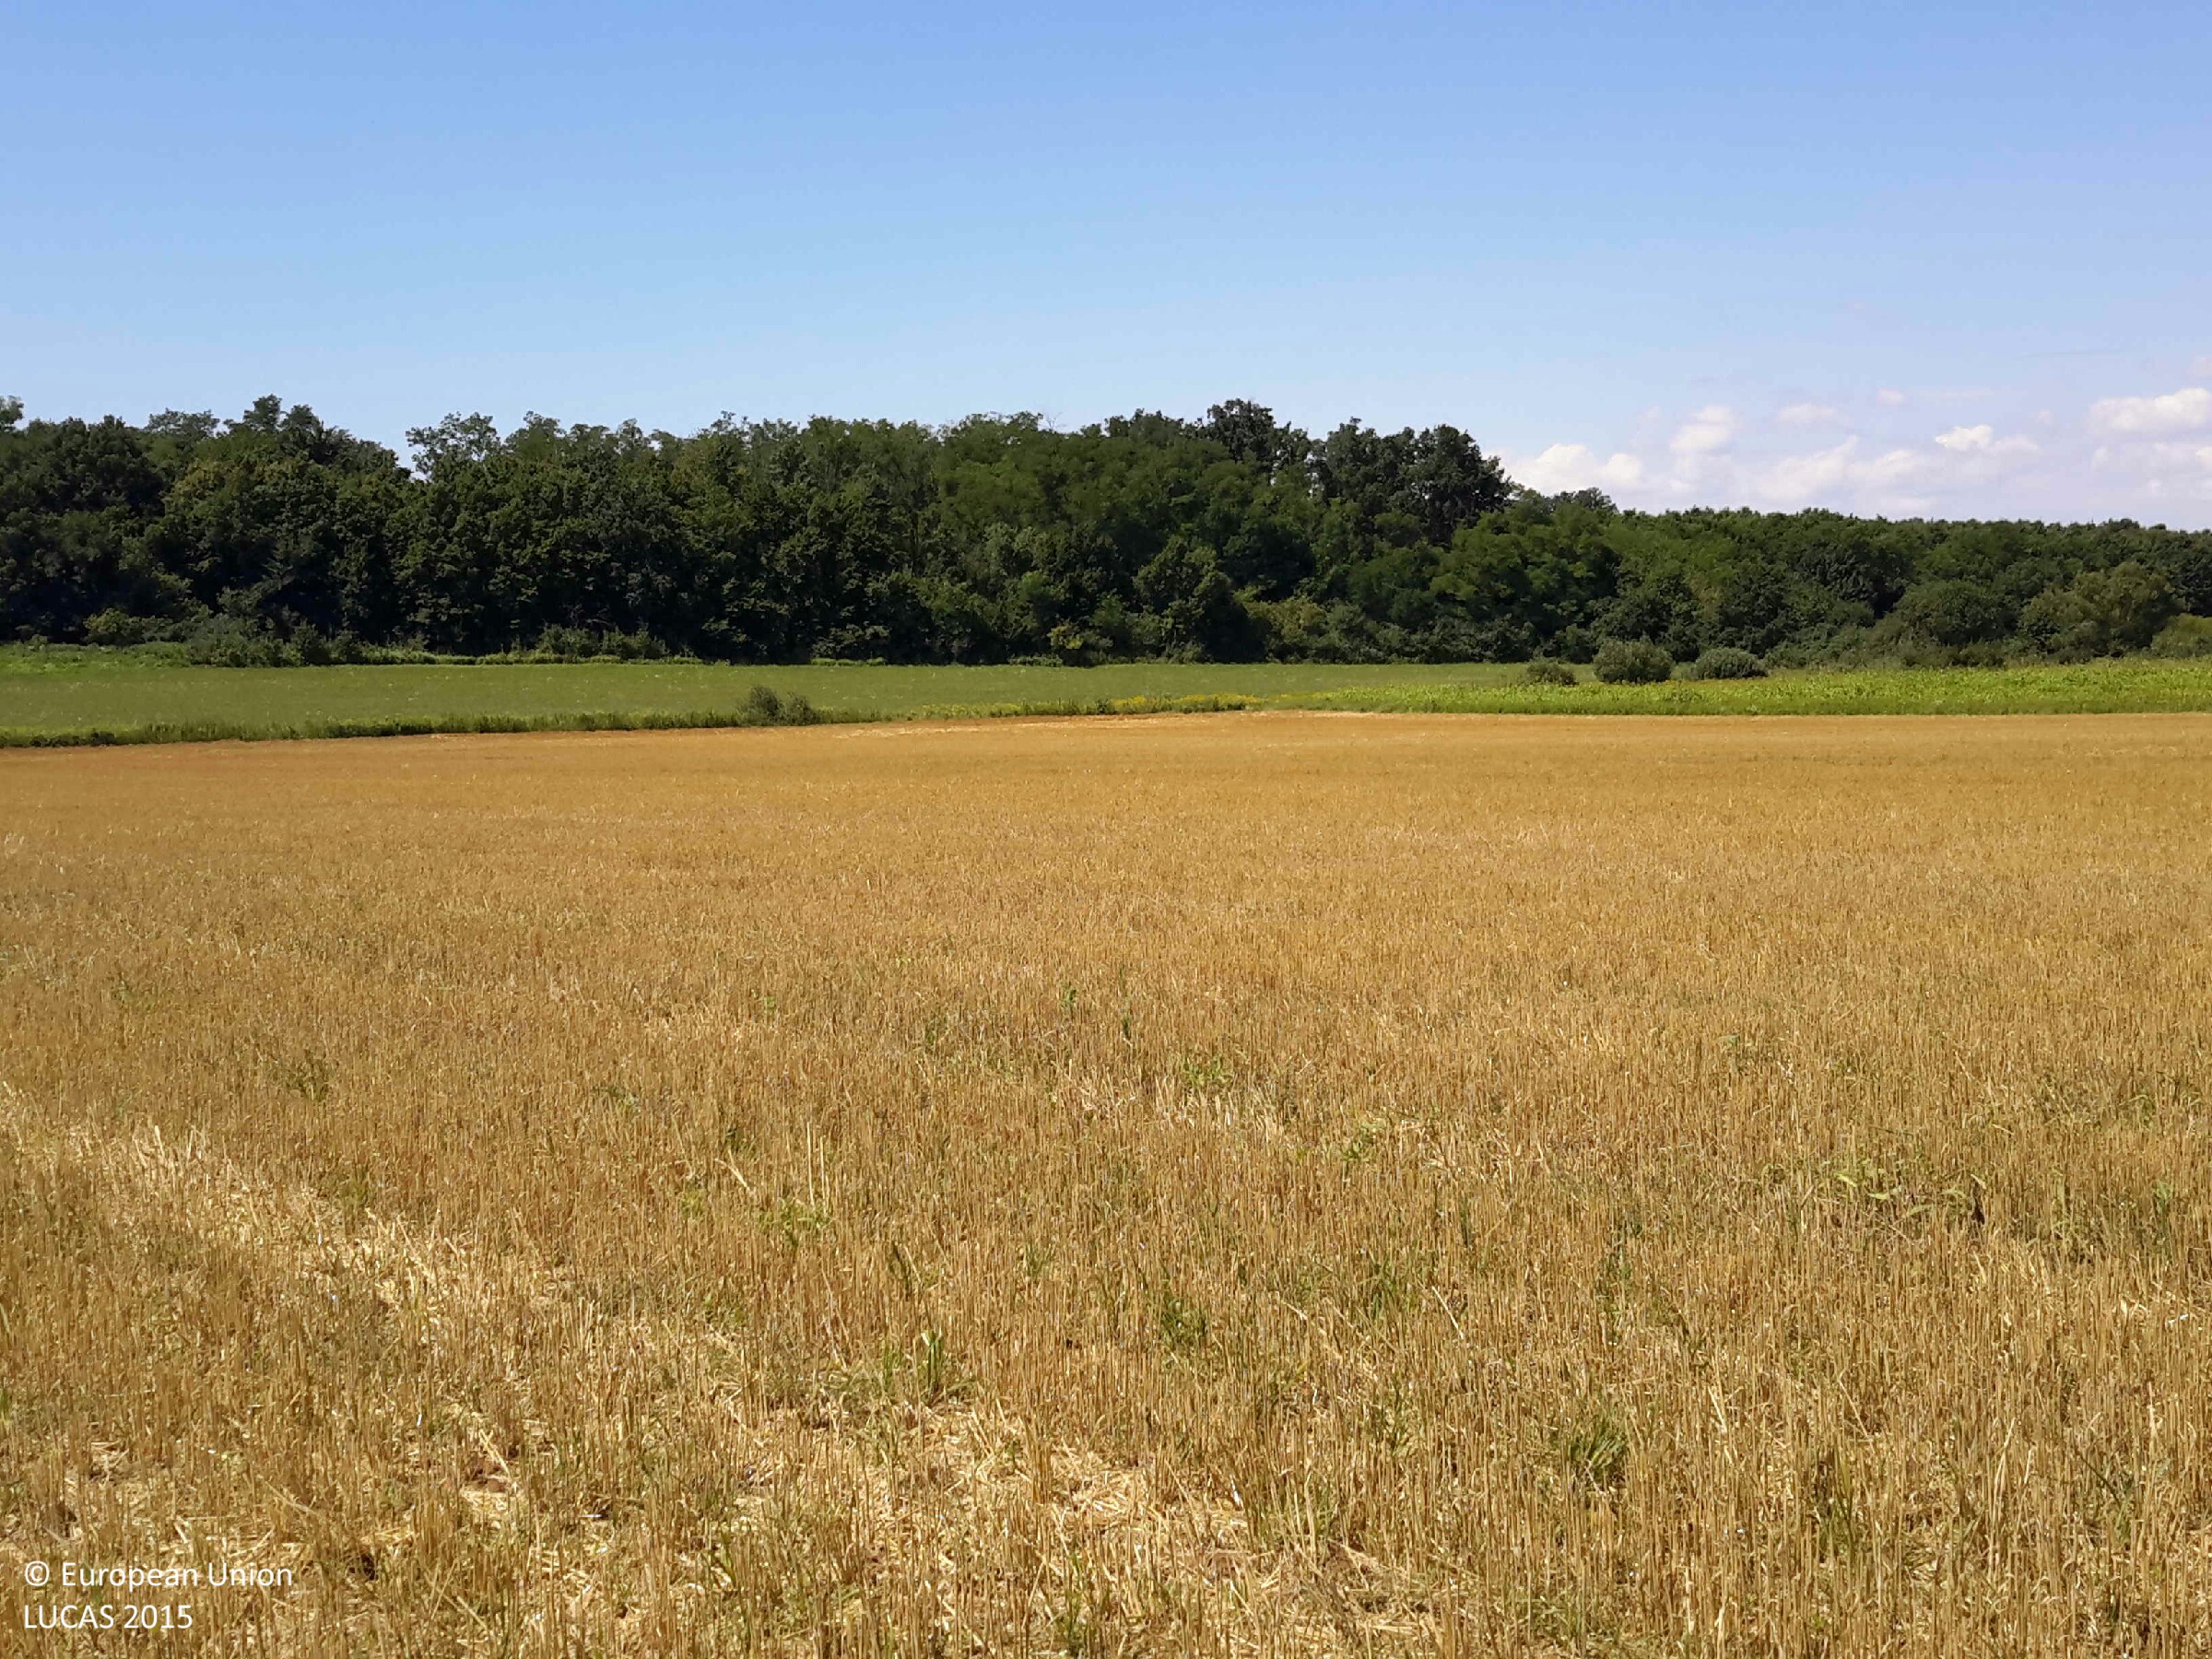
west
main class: Cropland
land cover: Common wheat
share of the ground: > 75 %
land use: Agriculture (excluding fallow land and kitchen gardens)
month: July
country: HU
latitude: 47.1957
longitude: 16.5898
